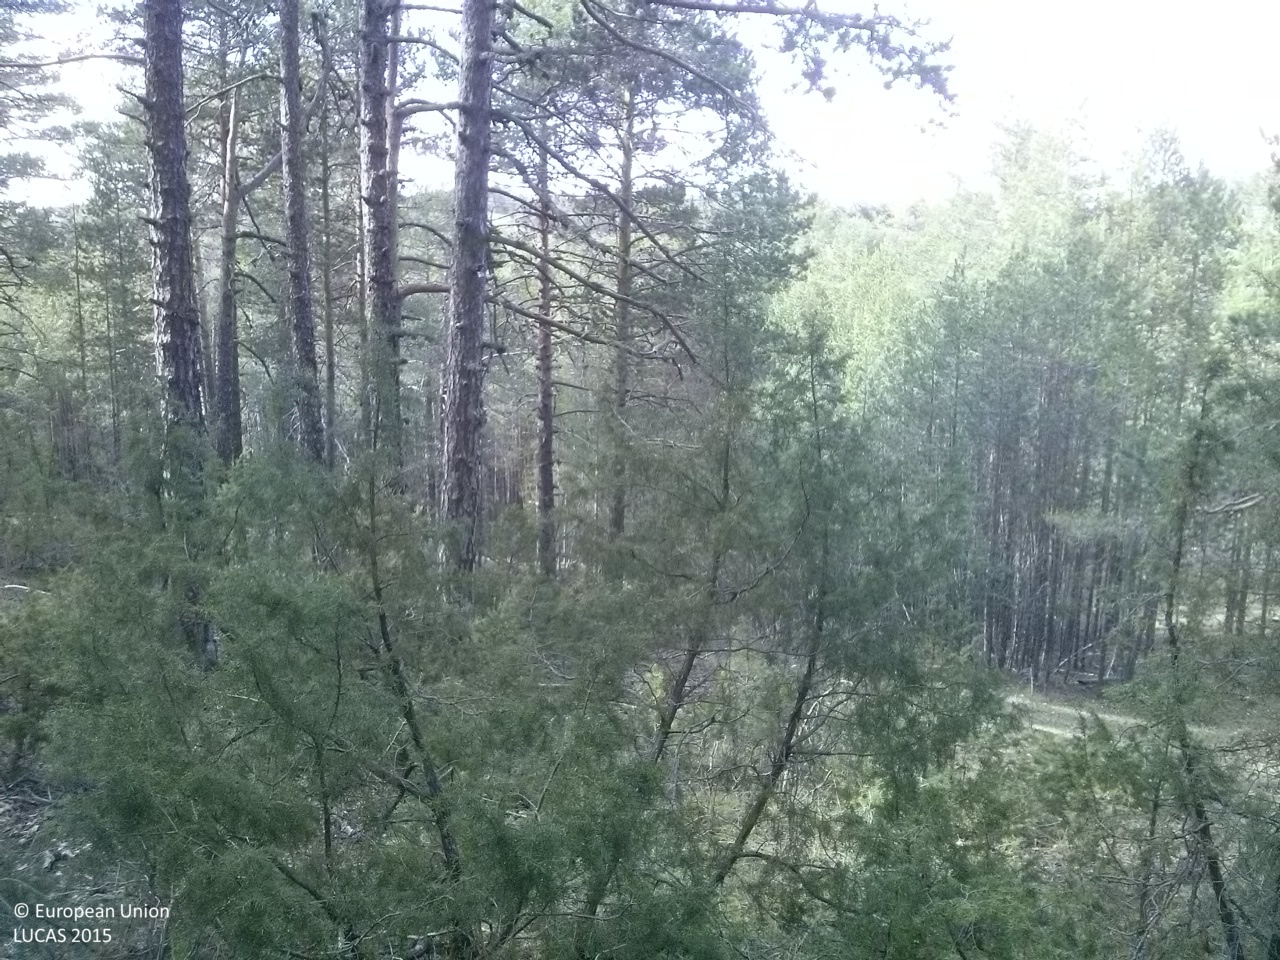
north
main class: Woodland
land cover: Pine dominated coniferous woodland
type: coniferous forest of the mediterranean region
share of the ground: > 75 %
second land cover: Grassland without tree/shrub cover
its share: 10 - 25 %
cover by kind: coniferous forest trees 90 %, herbaceous plants 10 %
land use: Forestry
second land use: Agriculture (excluding fallow land and kitchen gardens)
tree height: > 5 m
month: April
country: ES
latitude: 40.2938
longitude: -1.8621
